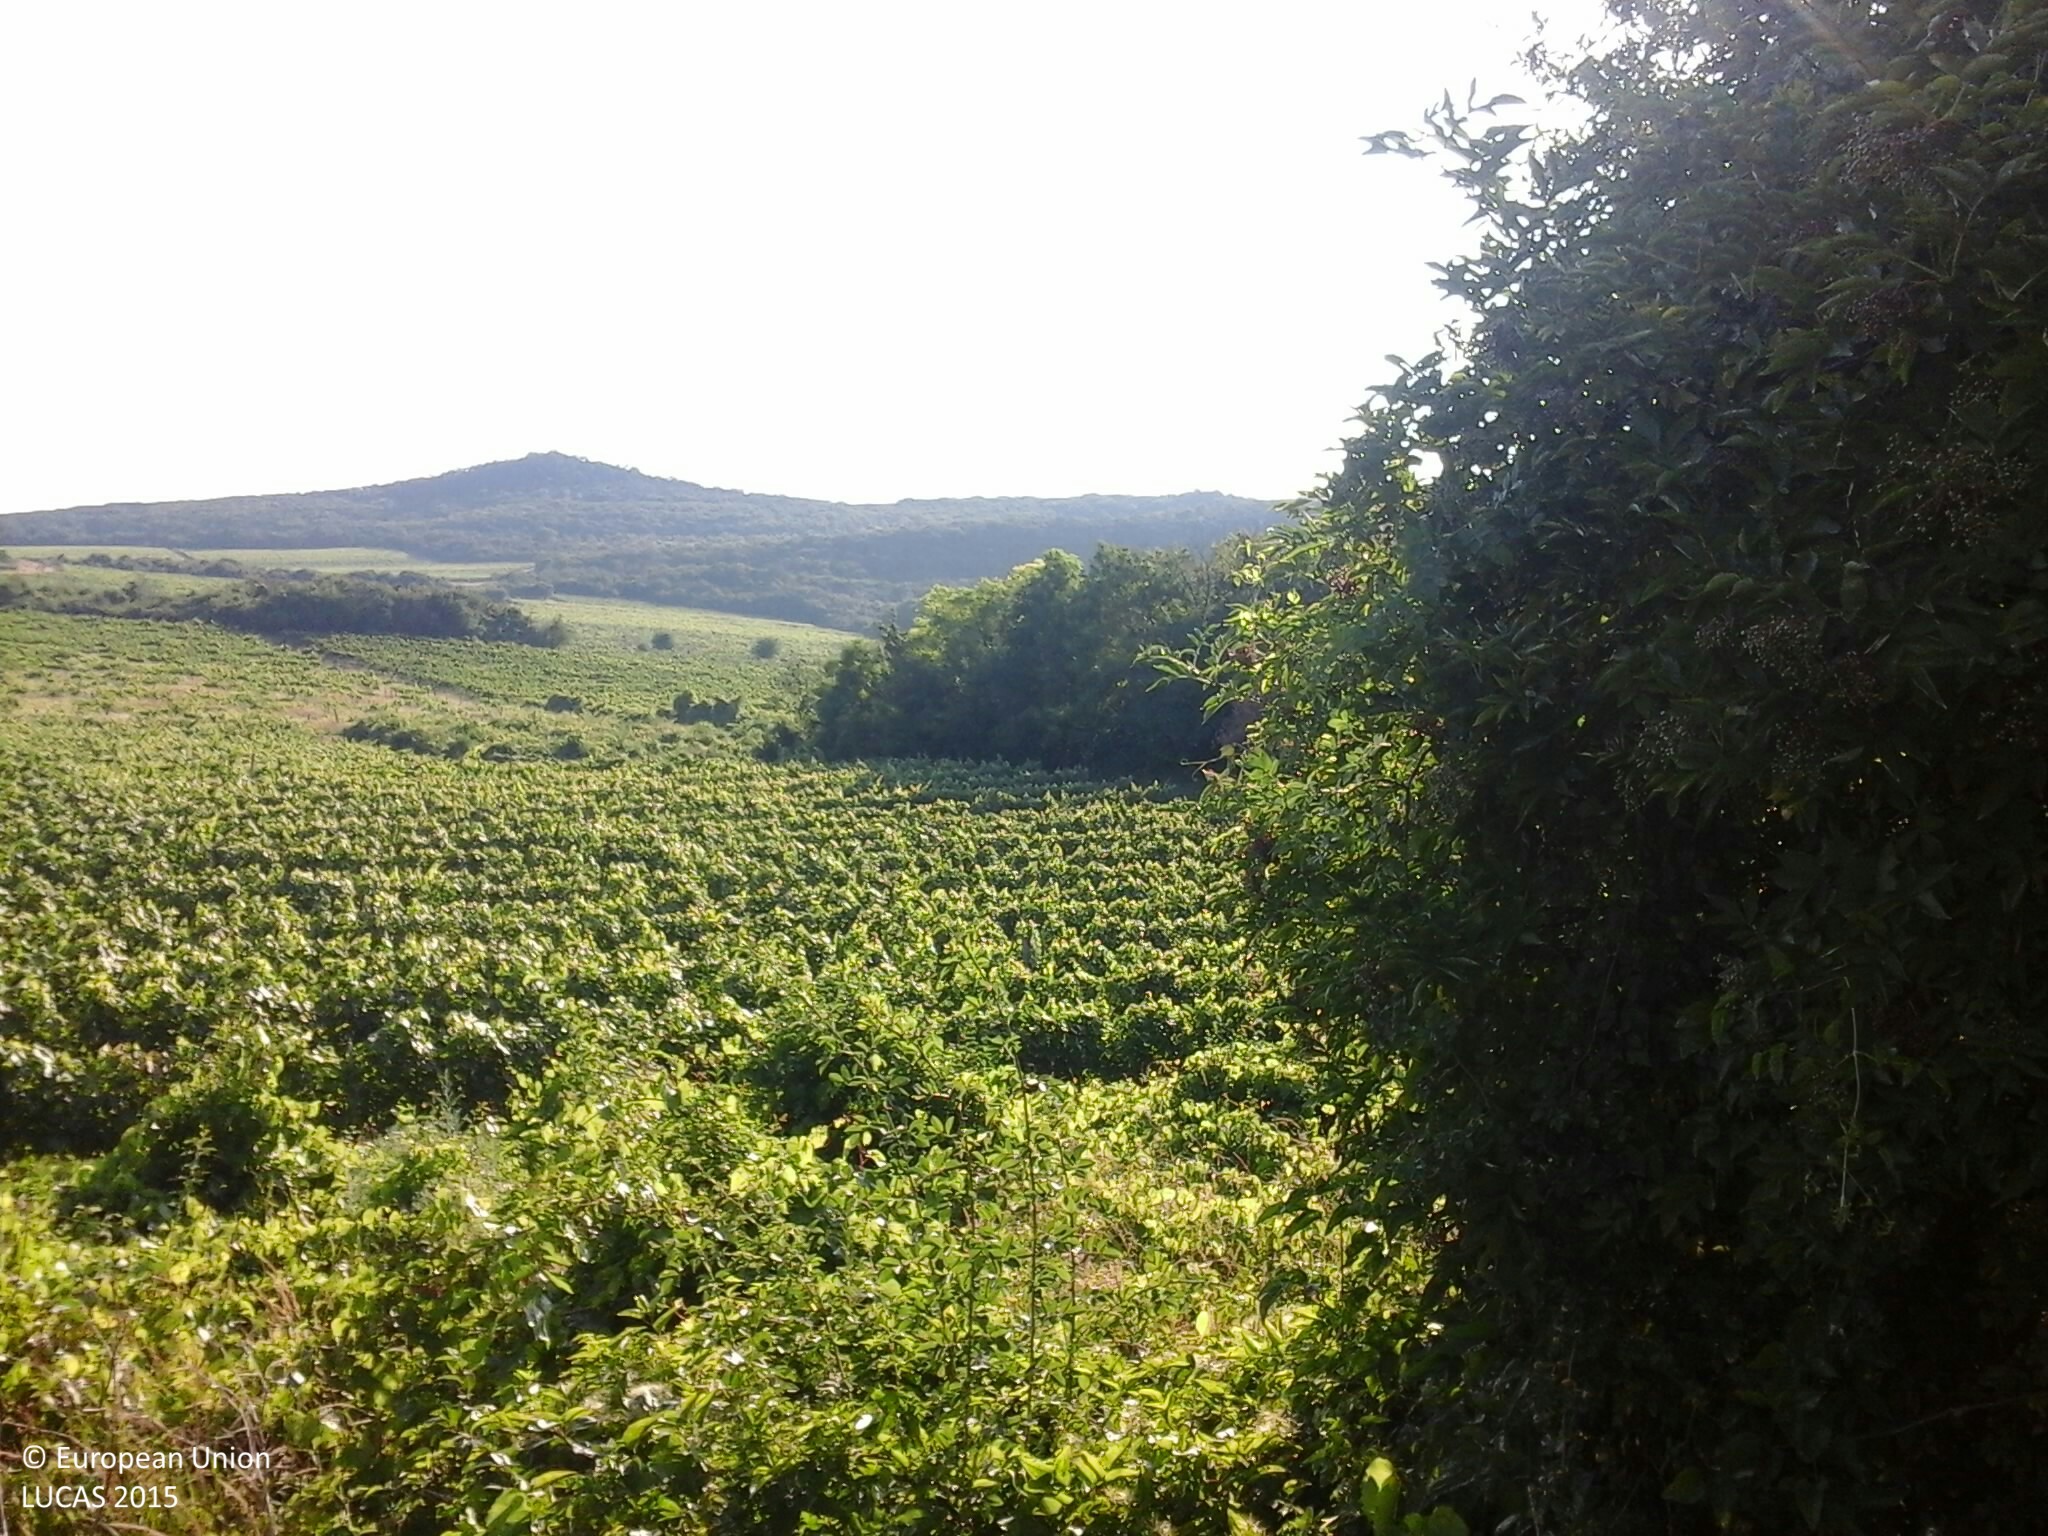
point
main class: Cropland
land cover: Vineyards
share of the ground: 50 - 75 %
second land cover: Grassland without tree/shrub cover
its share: 25 - 50 %
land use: Agriculture (excluding fallow land and kitchen gardens)
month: July
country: HU
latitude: 46.9110
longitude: 17.8726
